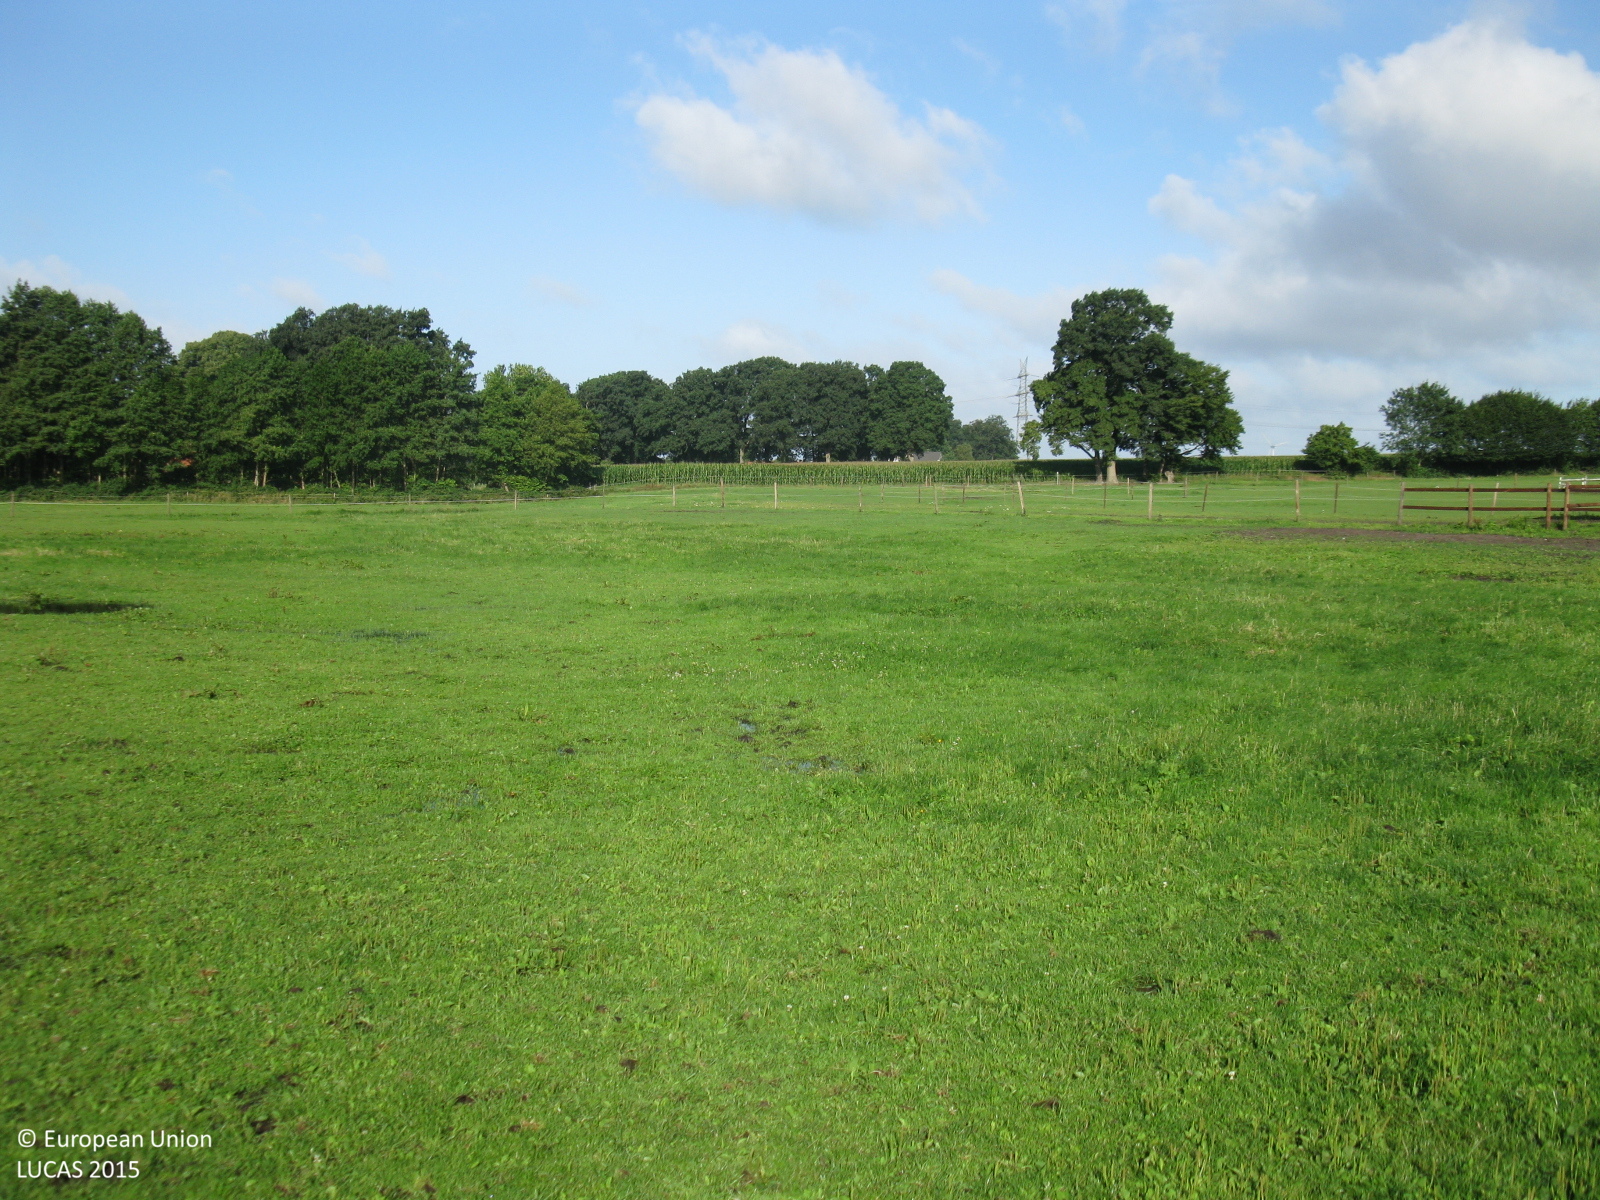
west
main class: Grassland
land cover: Grassland without tree/shrub cover
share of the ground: > 75 %
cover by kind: herbaceous plants 100 %
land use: Agriculture (excluding fallow land and kitchen gardens)
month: July
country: DE
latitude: 53.0521
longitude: 8.5833
